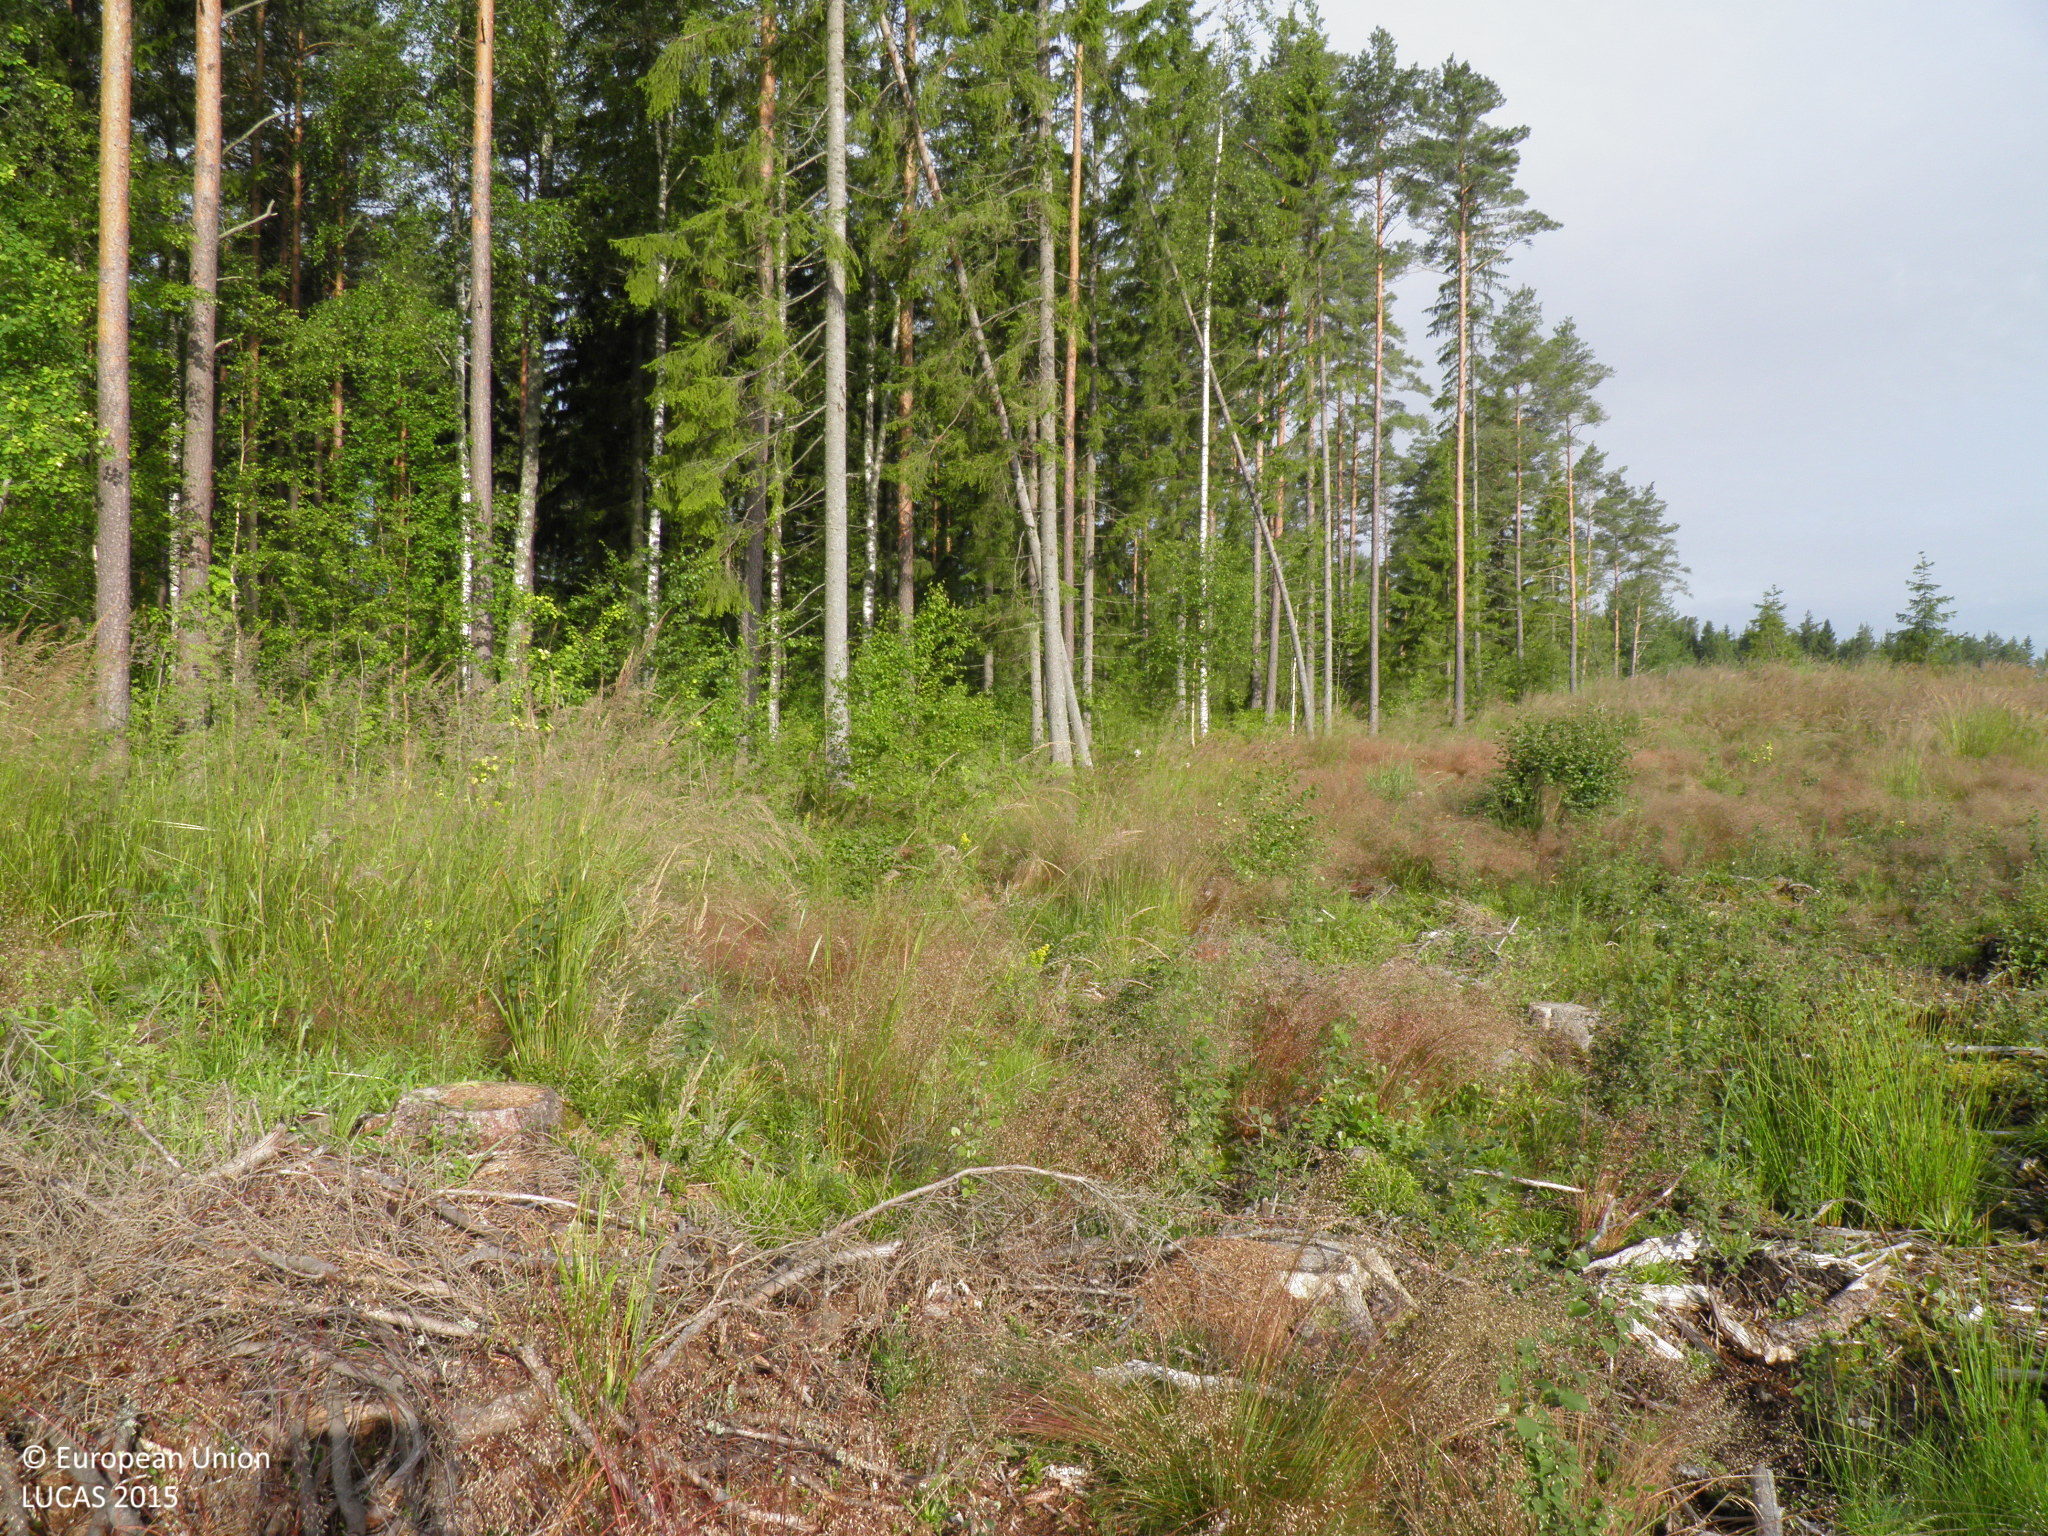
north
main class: Grassland
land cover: Grassland with sparse tree/shrub cover
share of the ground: 50 - 75 %
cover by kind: herbaceous plants 40 %, unconsolidated bare surface 35 %, shrubs 10 %, lichens and mosses 10 %, coniferous forest trees 5 %
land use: Forestry
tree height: < 5 m
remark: Clear cut
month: July
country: FI
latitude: 60.1162
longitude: 22.6888
